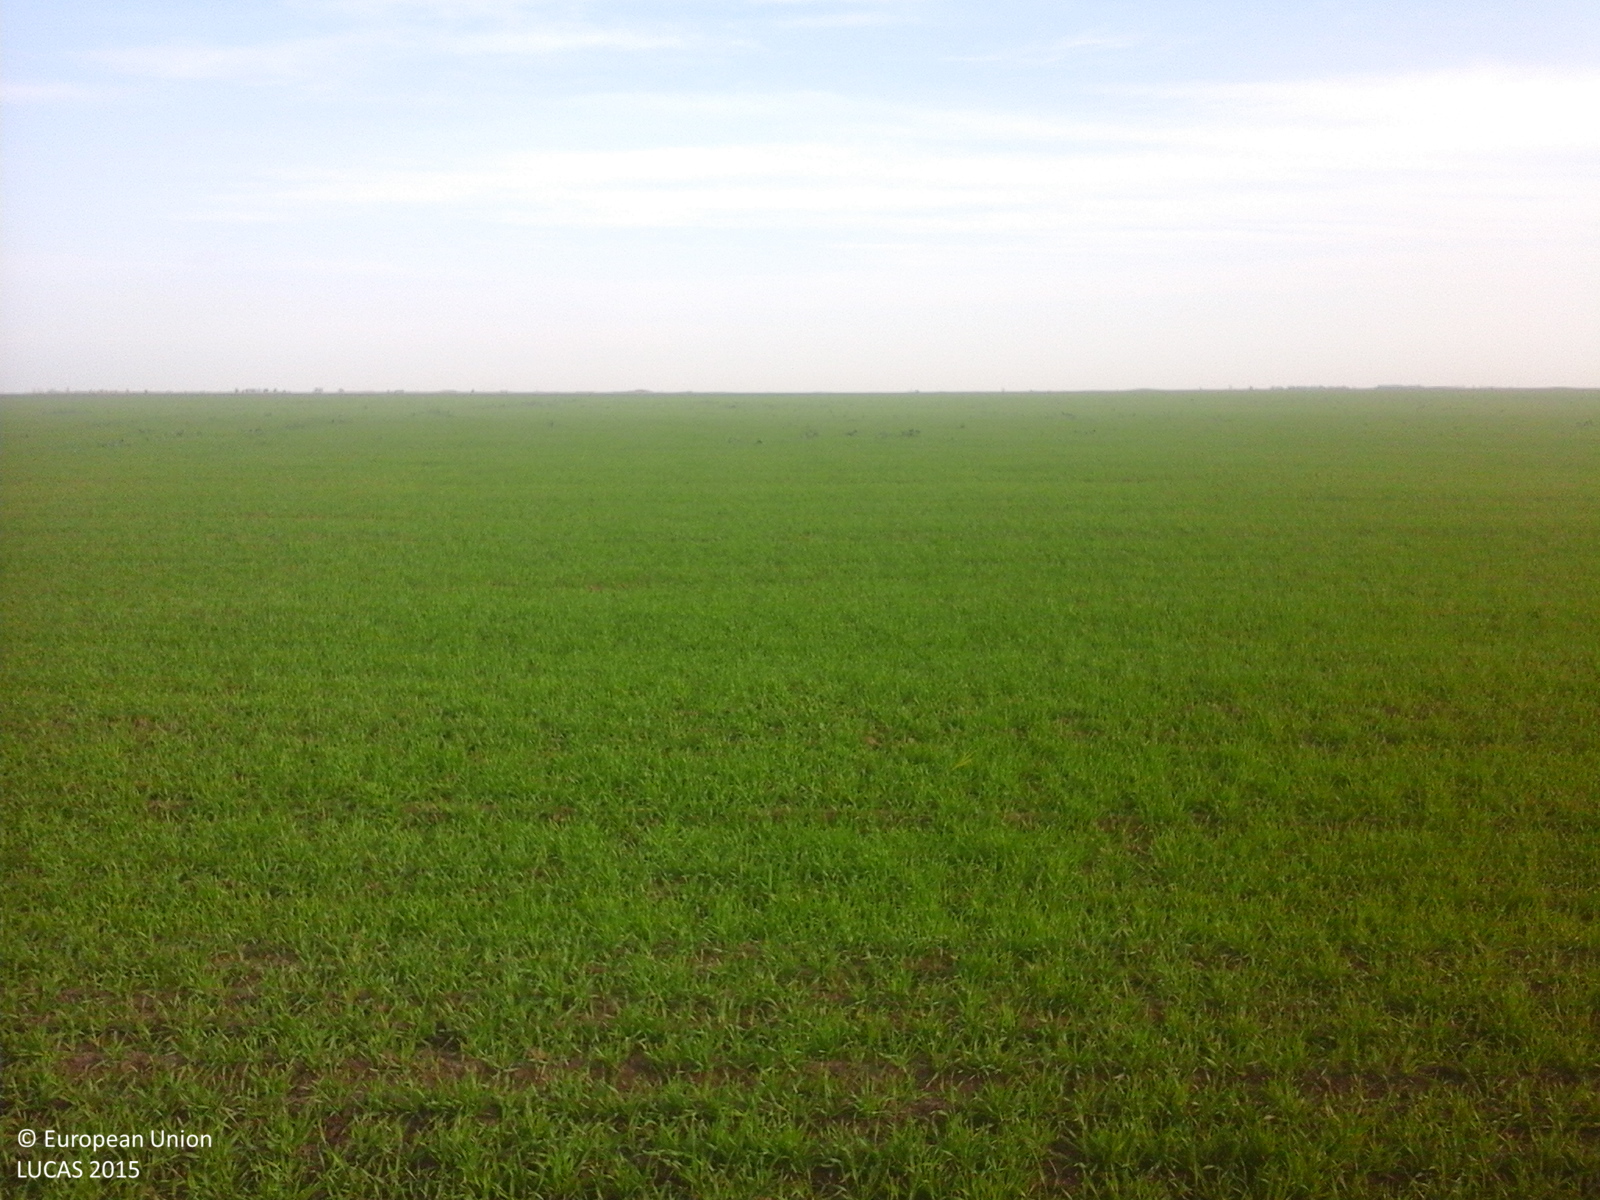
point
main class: Cropland
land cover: Common wheat
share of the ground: > 75 %
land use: Agriculture (excluding fallow land and kitchen gardens)
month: October
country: RO
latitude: 45.2913
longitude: 27.2163
